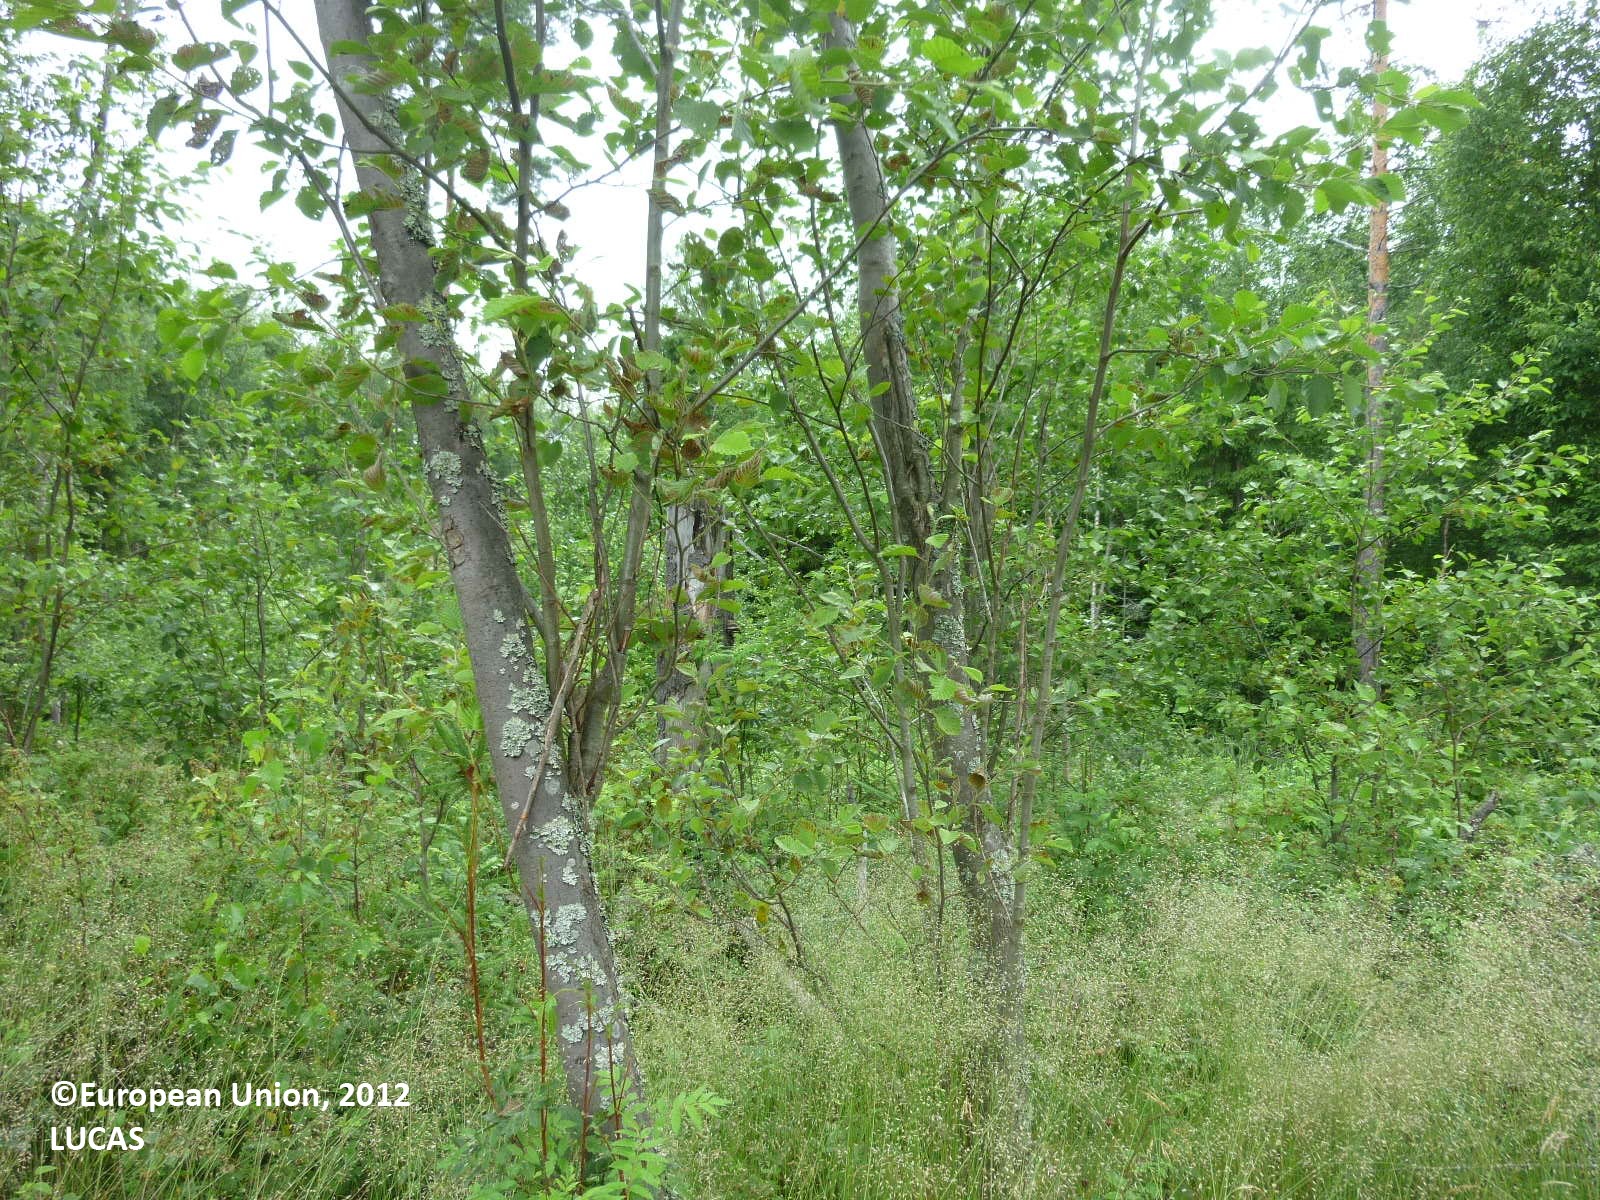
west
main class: Woodland
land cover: Broadleaved woodland
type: boreal forest
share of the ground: > 75 %
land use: Forestry
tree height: > 5 m
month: July
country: FI
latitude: 61.4741
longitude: 22.2044
